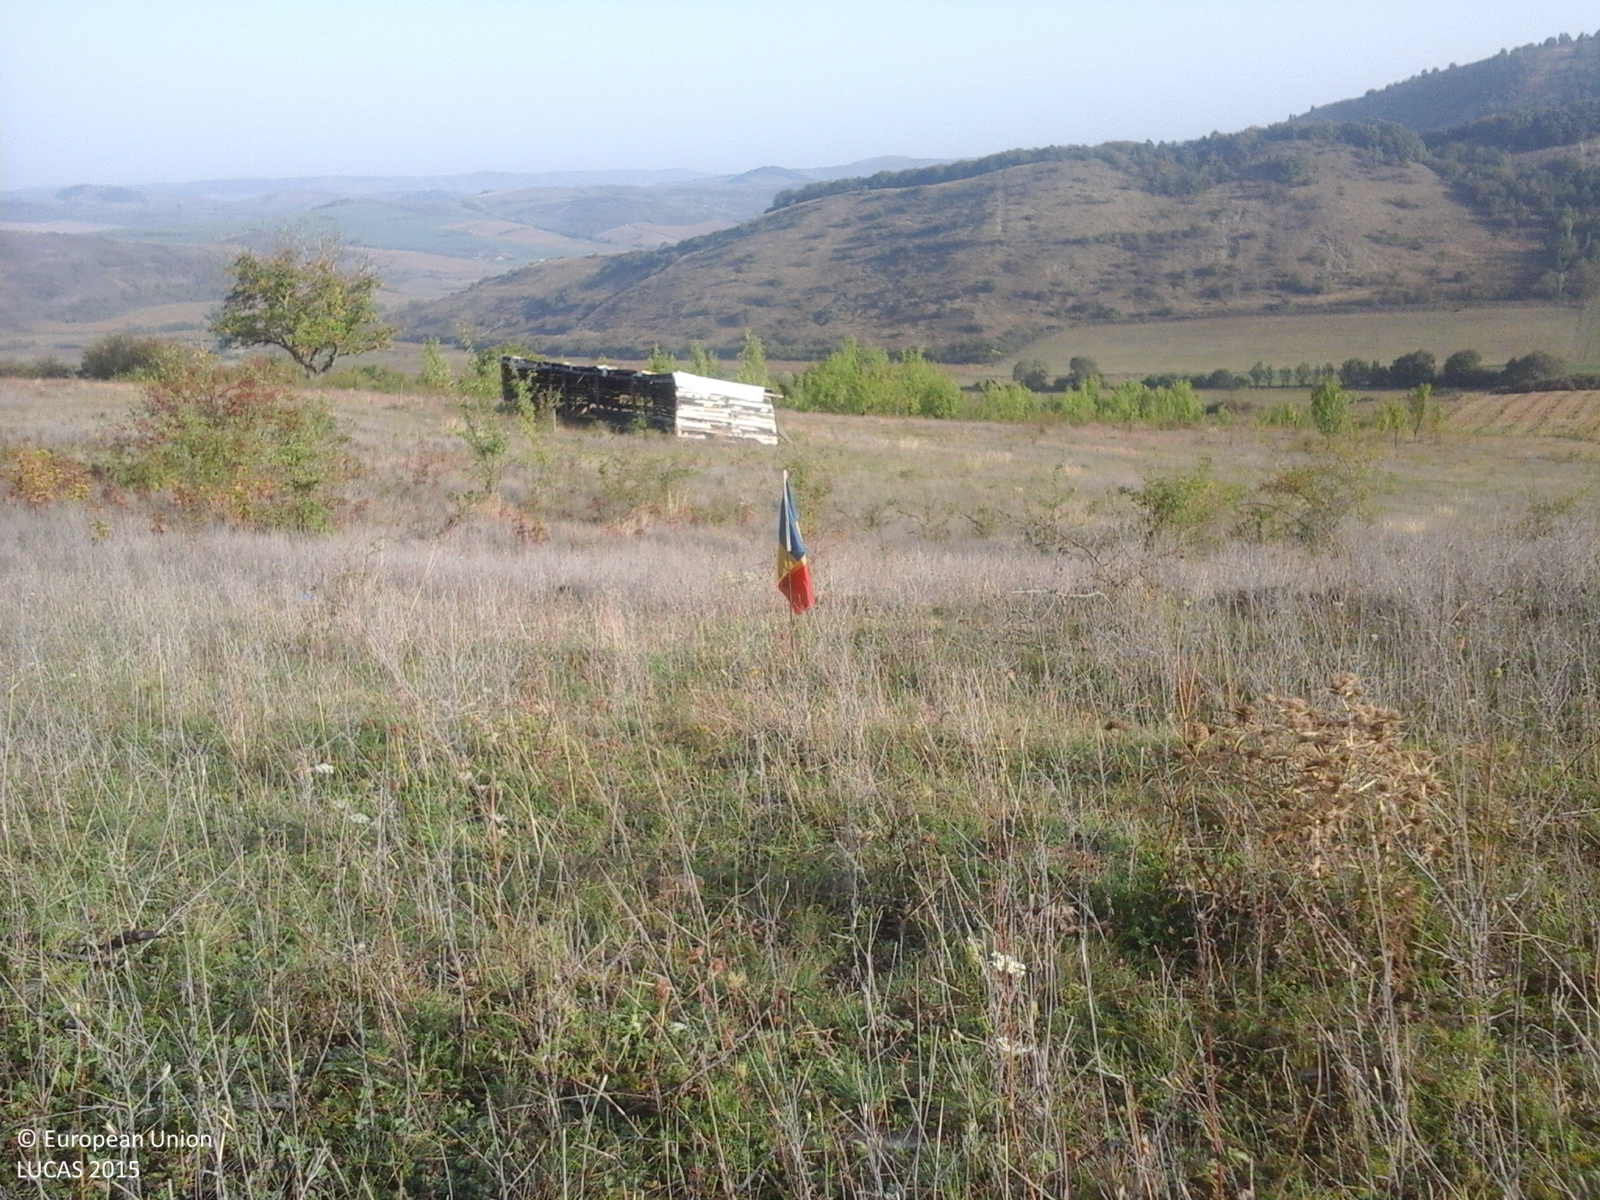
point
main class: Grassland
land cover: Spontaneously vegetated surfaces
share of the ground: > 75 %
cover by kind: herbaceous plants 100 %
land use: Agriculture (excluding fallow land and kitchen gardens)
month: September
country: RO
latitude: 46.9700
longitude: 23.9188
